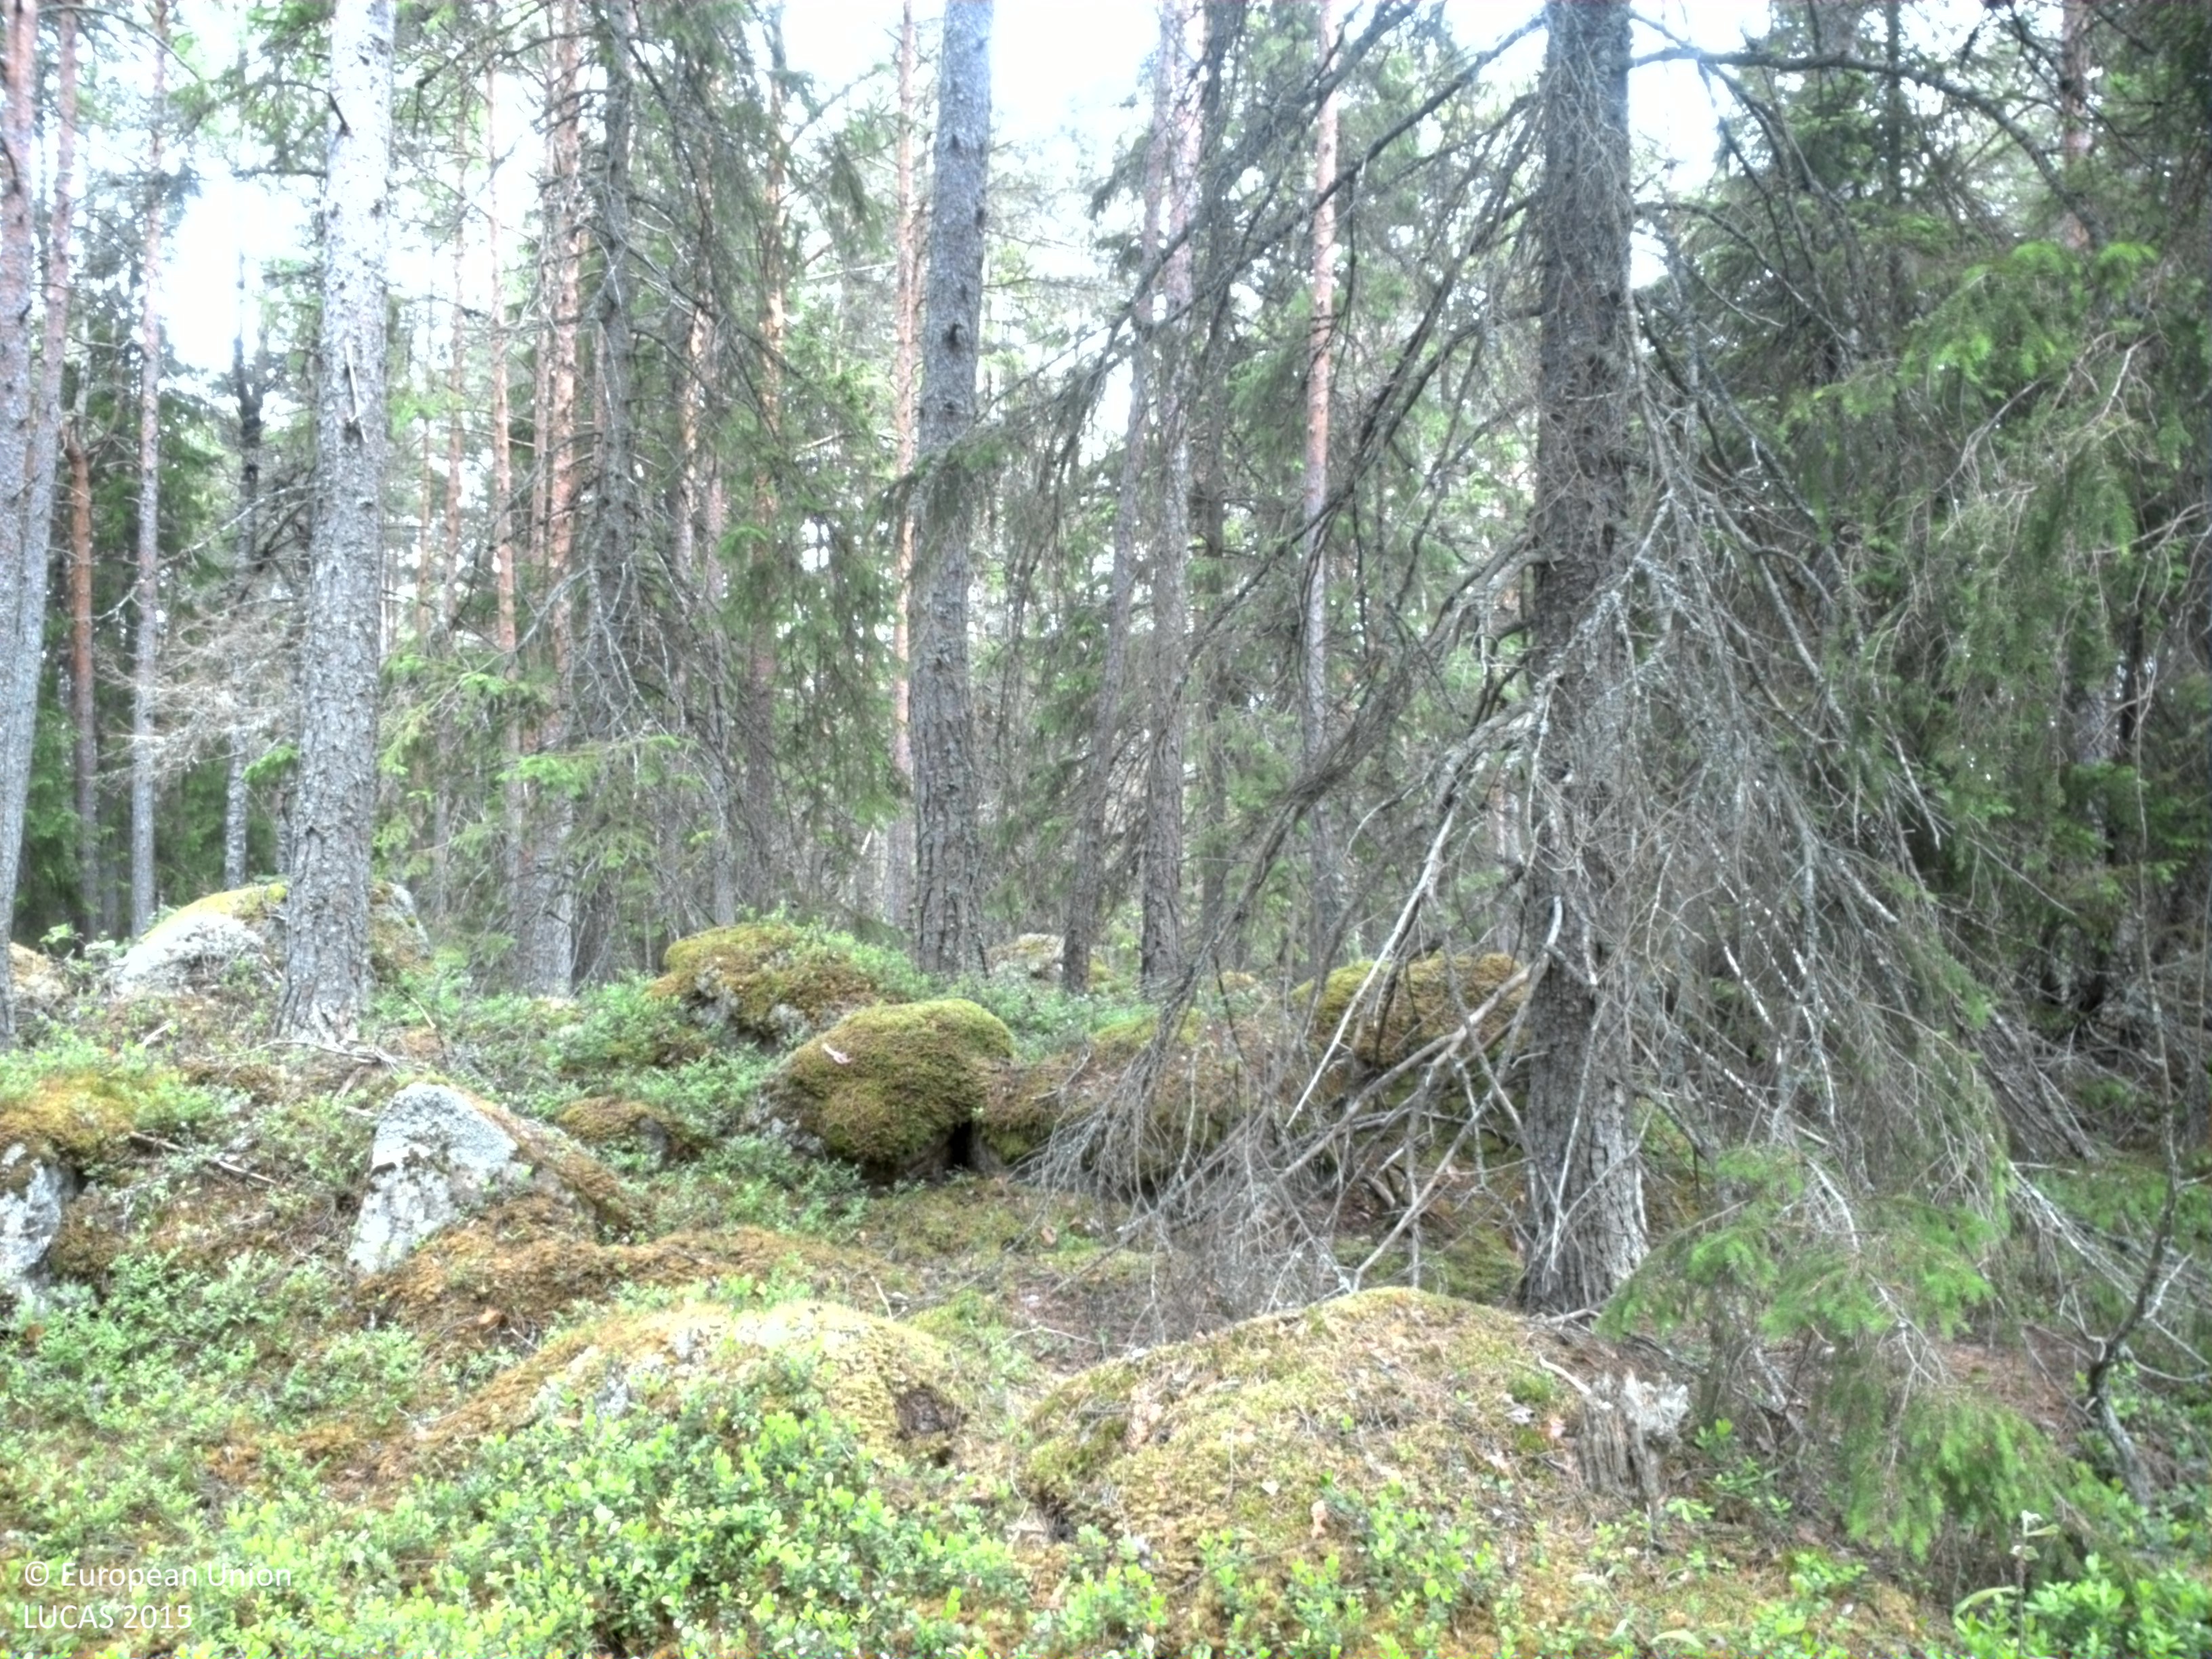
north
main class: Woodland
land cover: Pine dominated coniferous woodland
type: boreal forest
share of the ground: 50 - 75 %
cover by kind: coniferous forest trees 70 %, lichens and mosses 15 %, herbaceous plants 10 %, broadleaved forest trees 5 %
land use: Forestry
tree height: > 5 m
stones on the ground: < 10 %
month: June
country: SE
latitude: 59.6326
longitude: 16.8914
